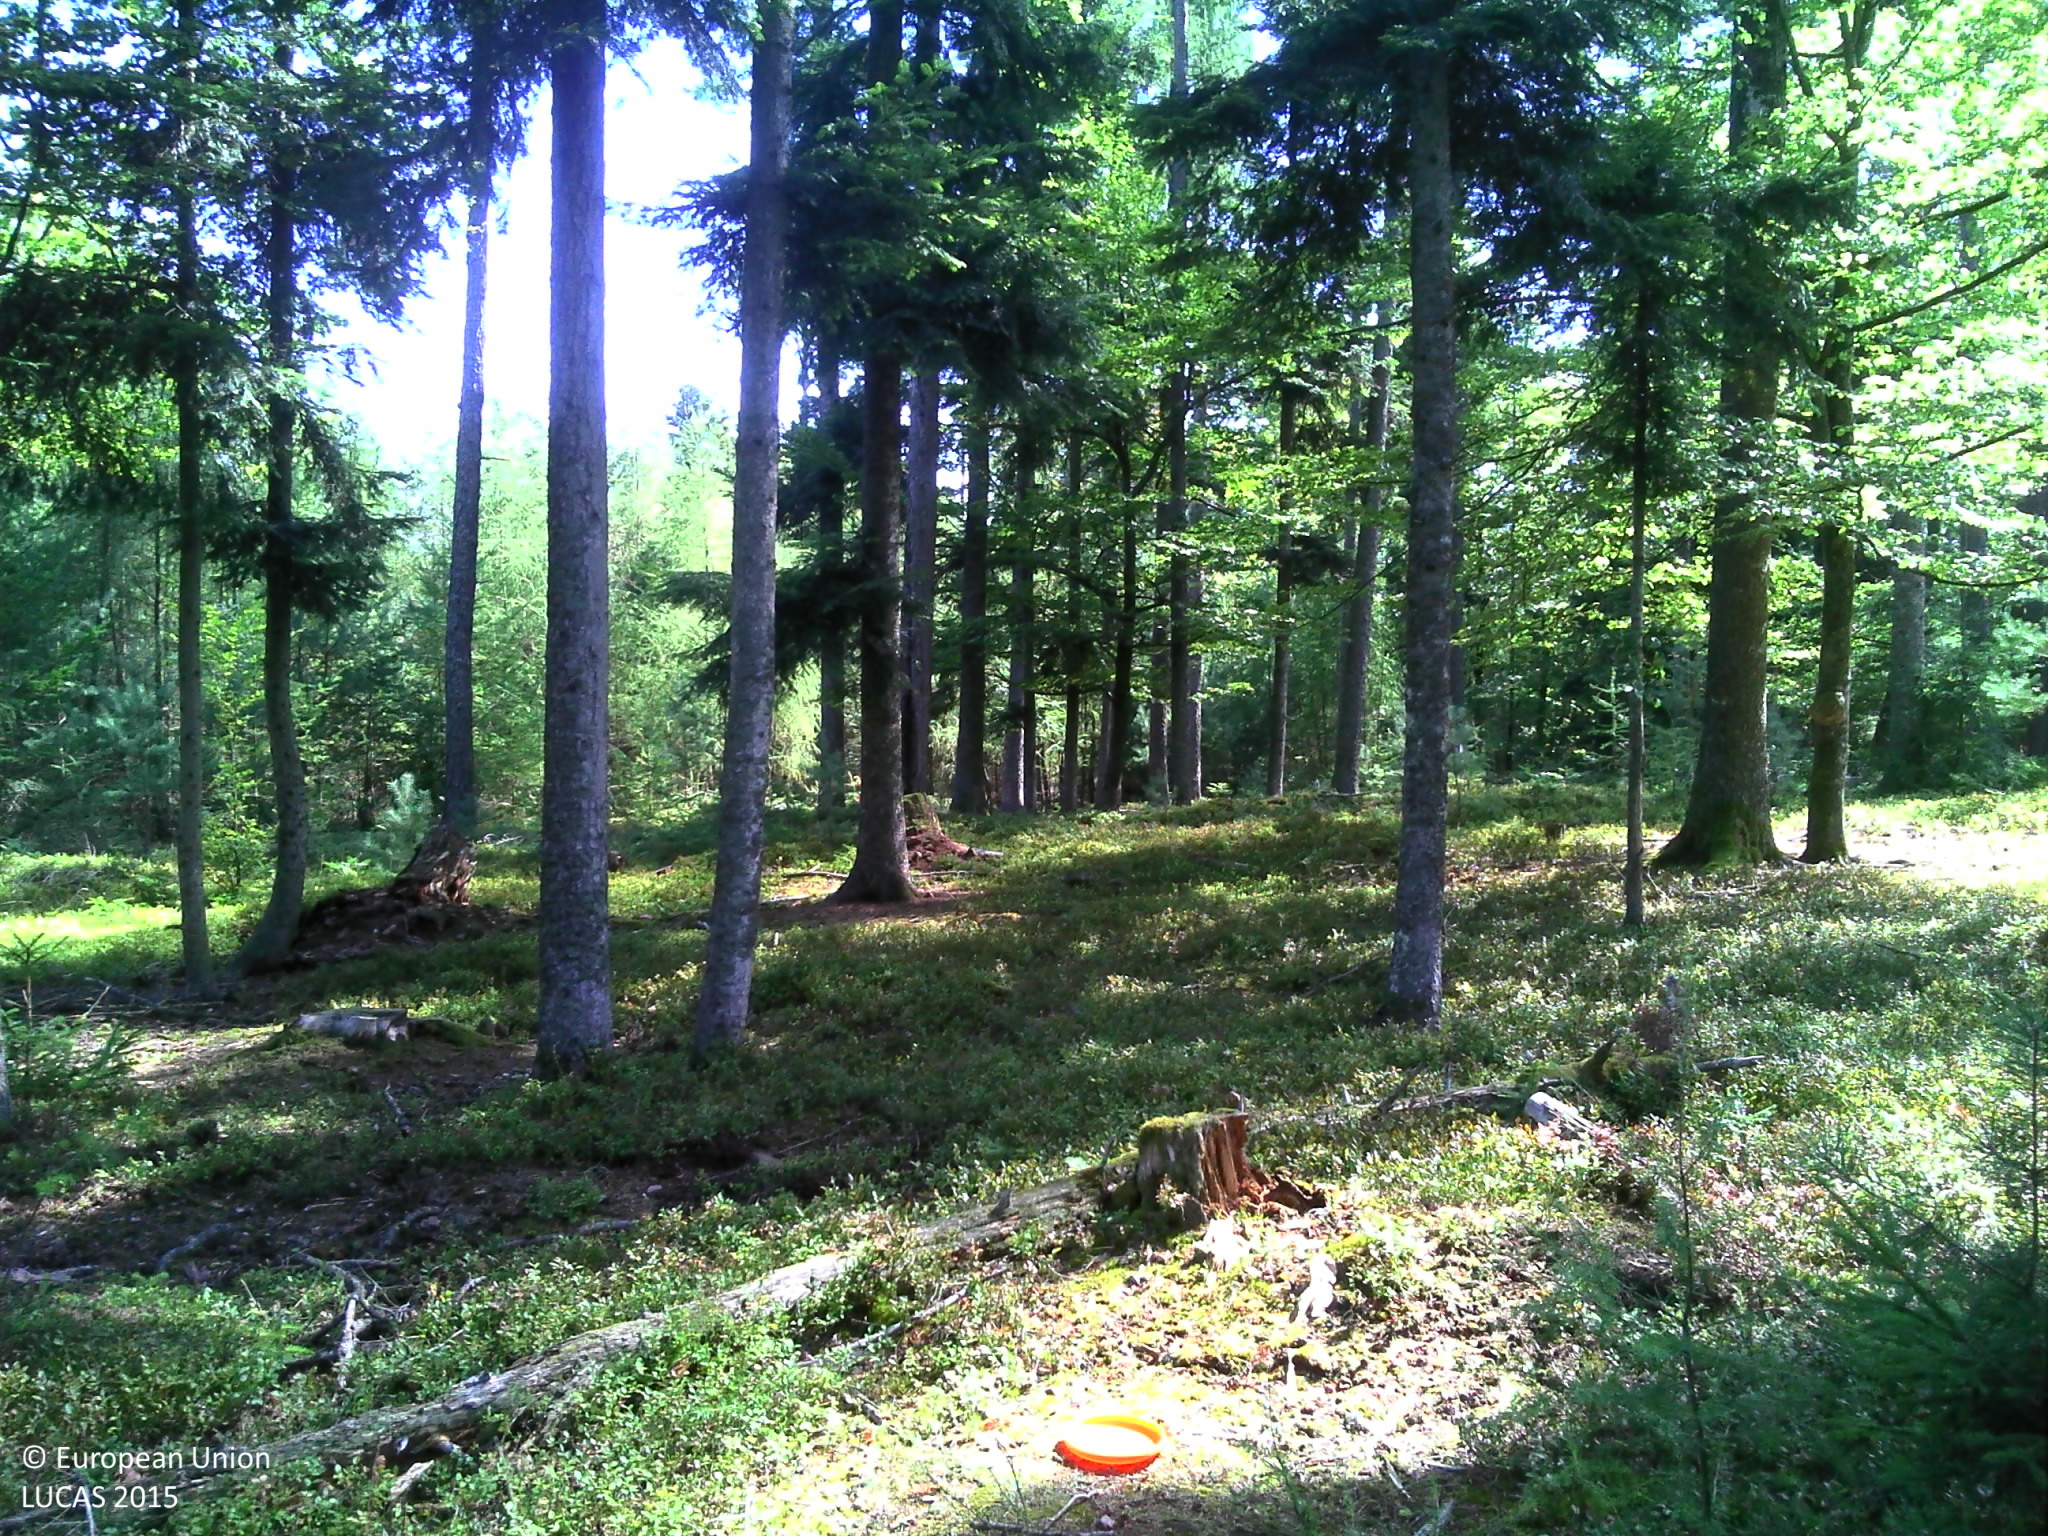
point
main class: Woodland
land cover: Spruce dominated mixed woodland
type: hemiboreal forest and nemoral coniferous forest and mixed broadleaved-coniferous forest
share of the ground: > 75 %
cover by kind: coniferous forest trees 60 %, broadleaved forest trees 30 %, herbaceous plants 10 %
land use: Forestry
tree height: > 5 m
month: August
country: FR
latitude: 48.2637
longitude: 7.3472
